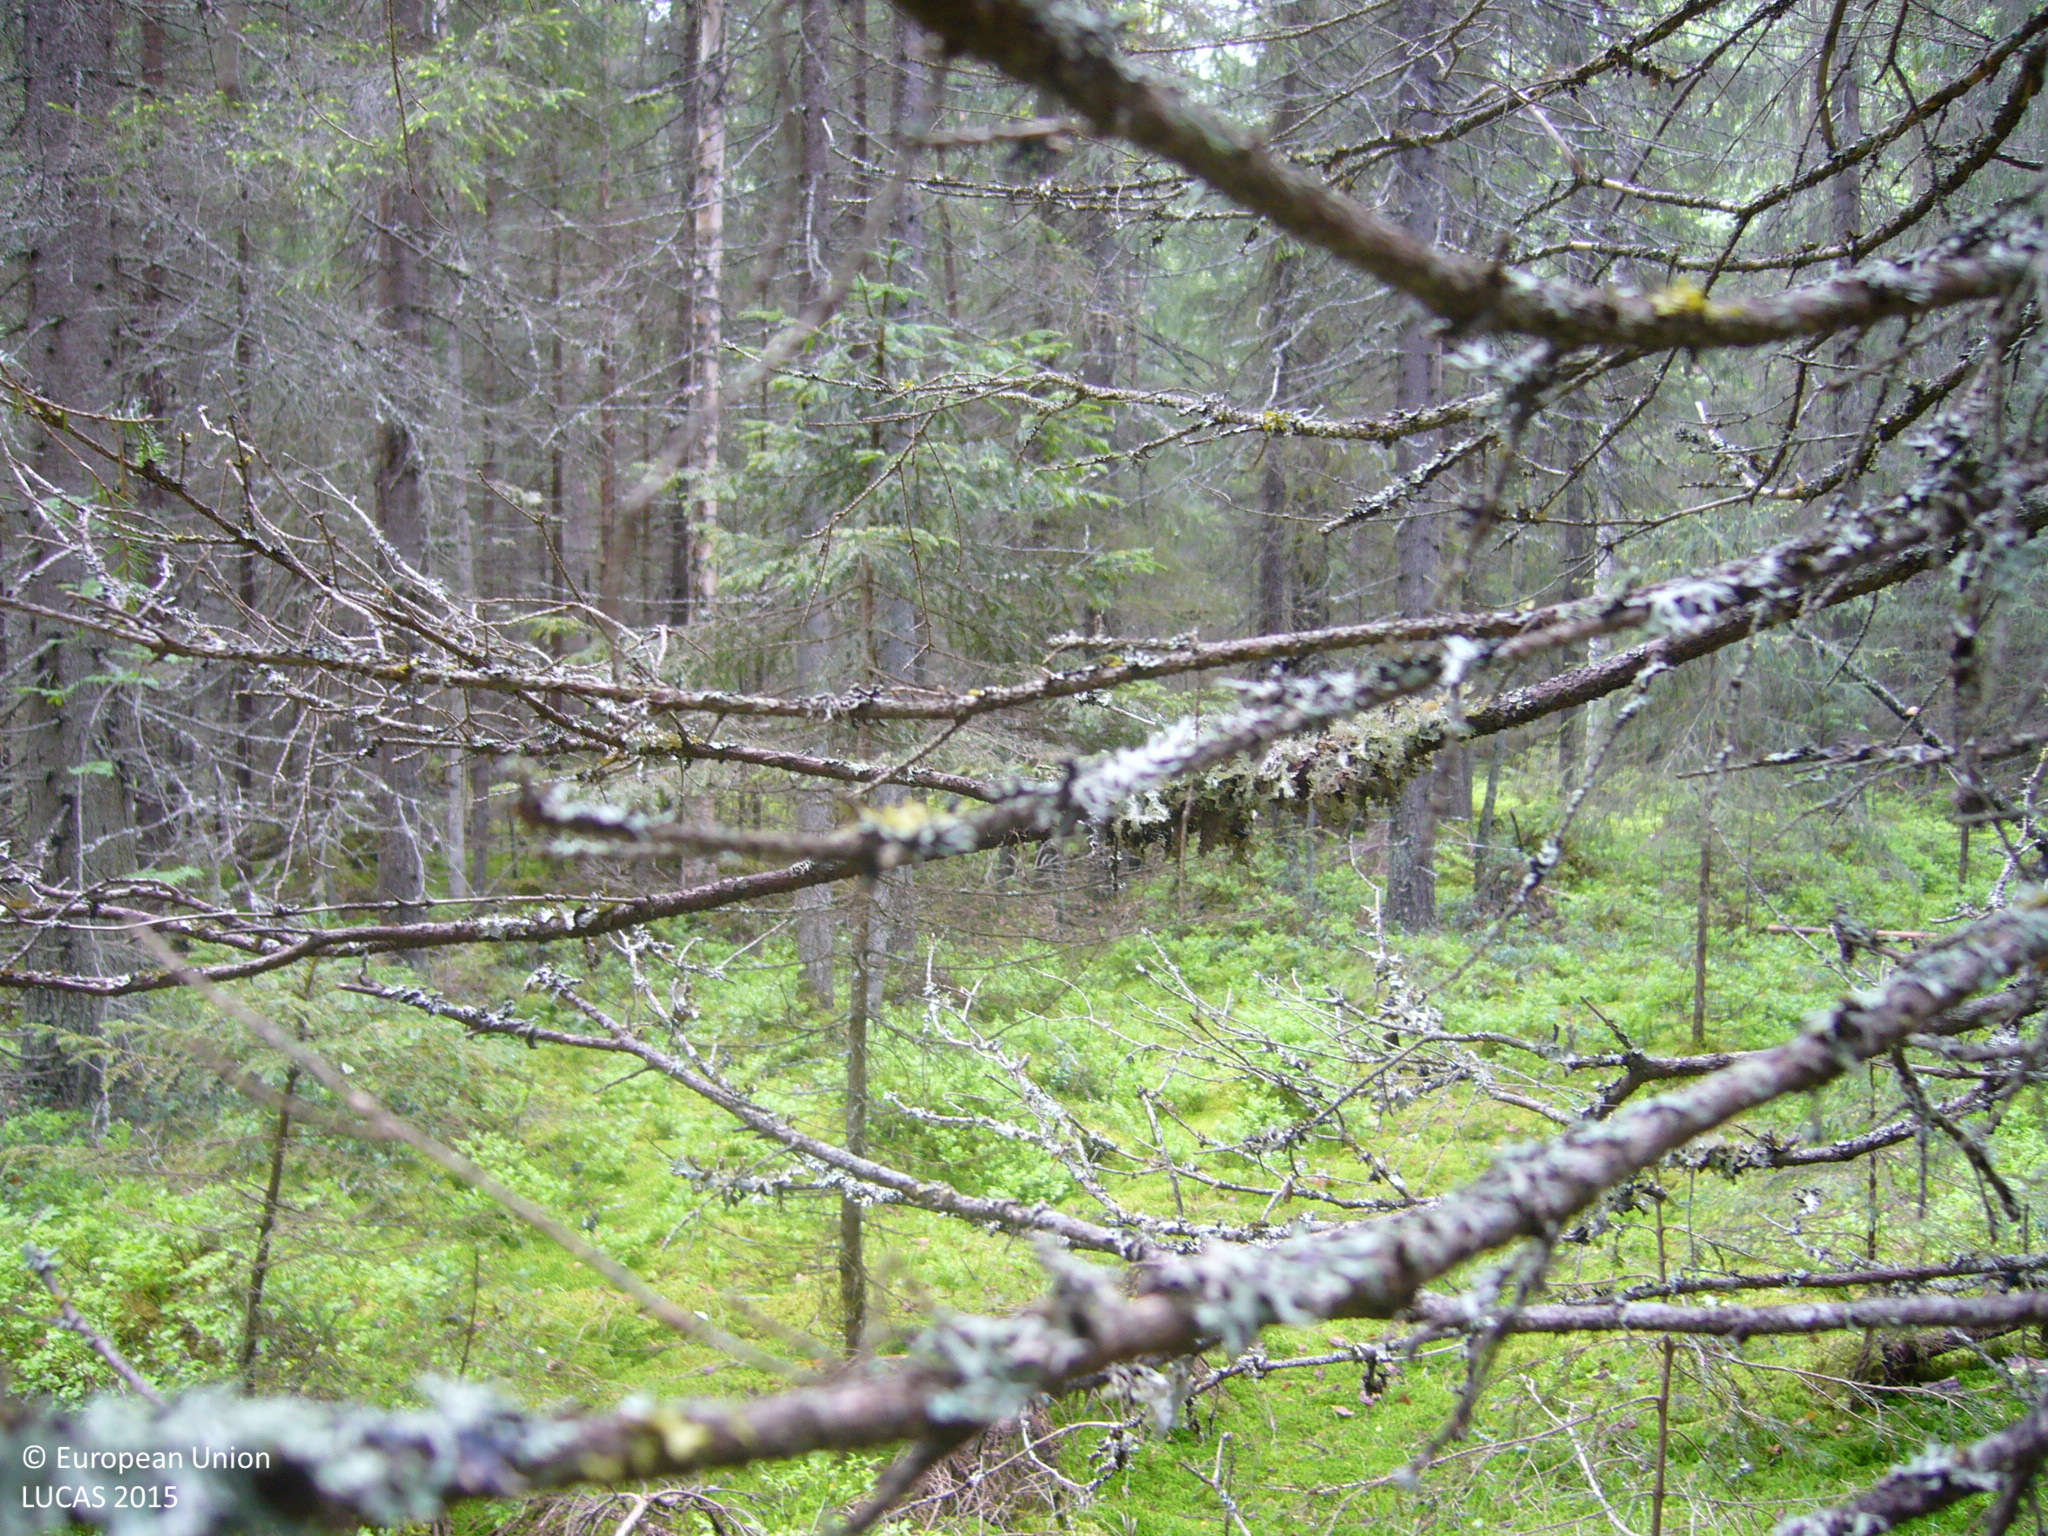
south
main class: Woodland
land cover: Spruce dominated mixed woodland
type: boreal forest
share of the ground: > 75 %
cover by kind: coniferous forest trees 60 %, broadleaved forest trees 30 %, shrubs 10 %
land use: Forestry
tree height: > 5 m
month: June
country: FI
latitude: 63.2396
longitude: 26.2269
